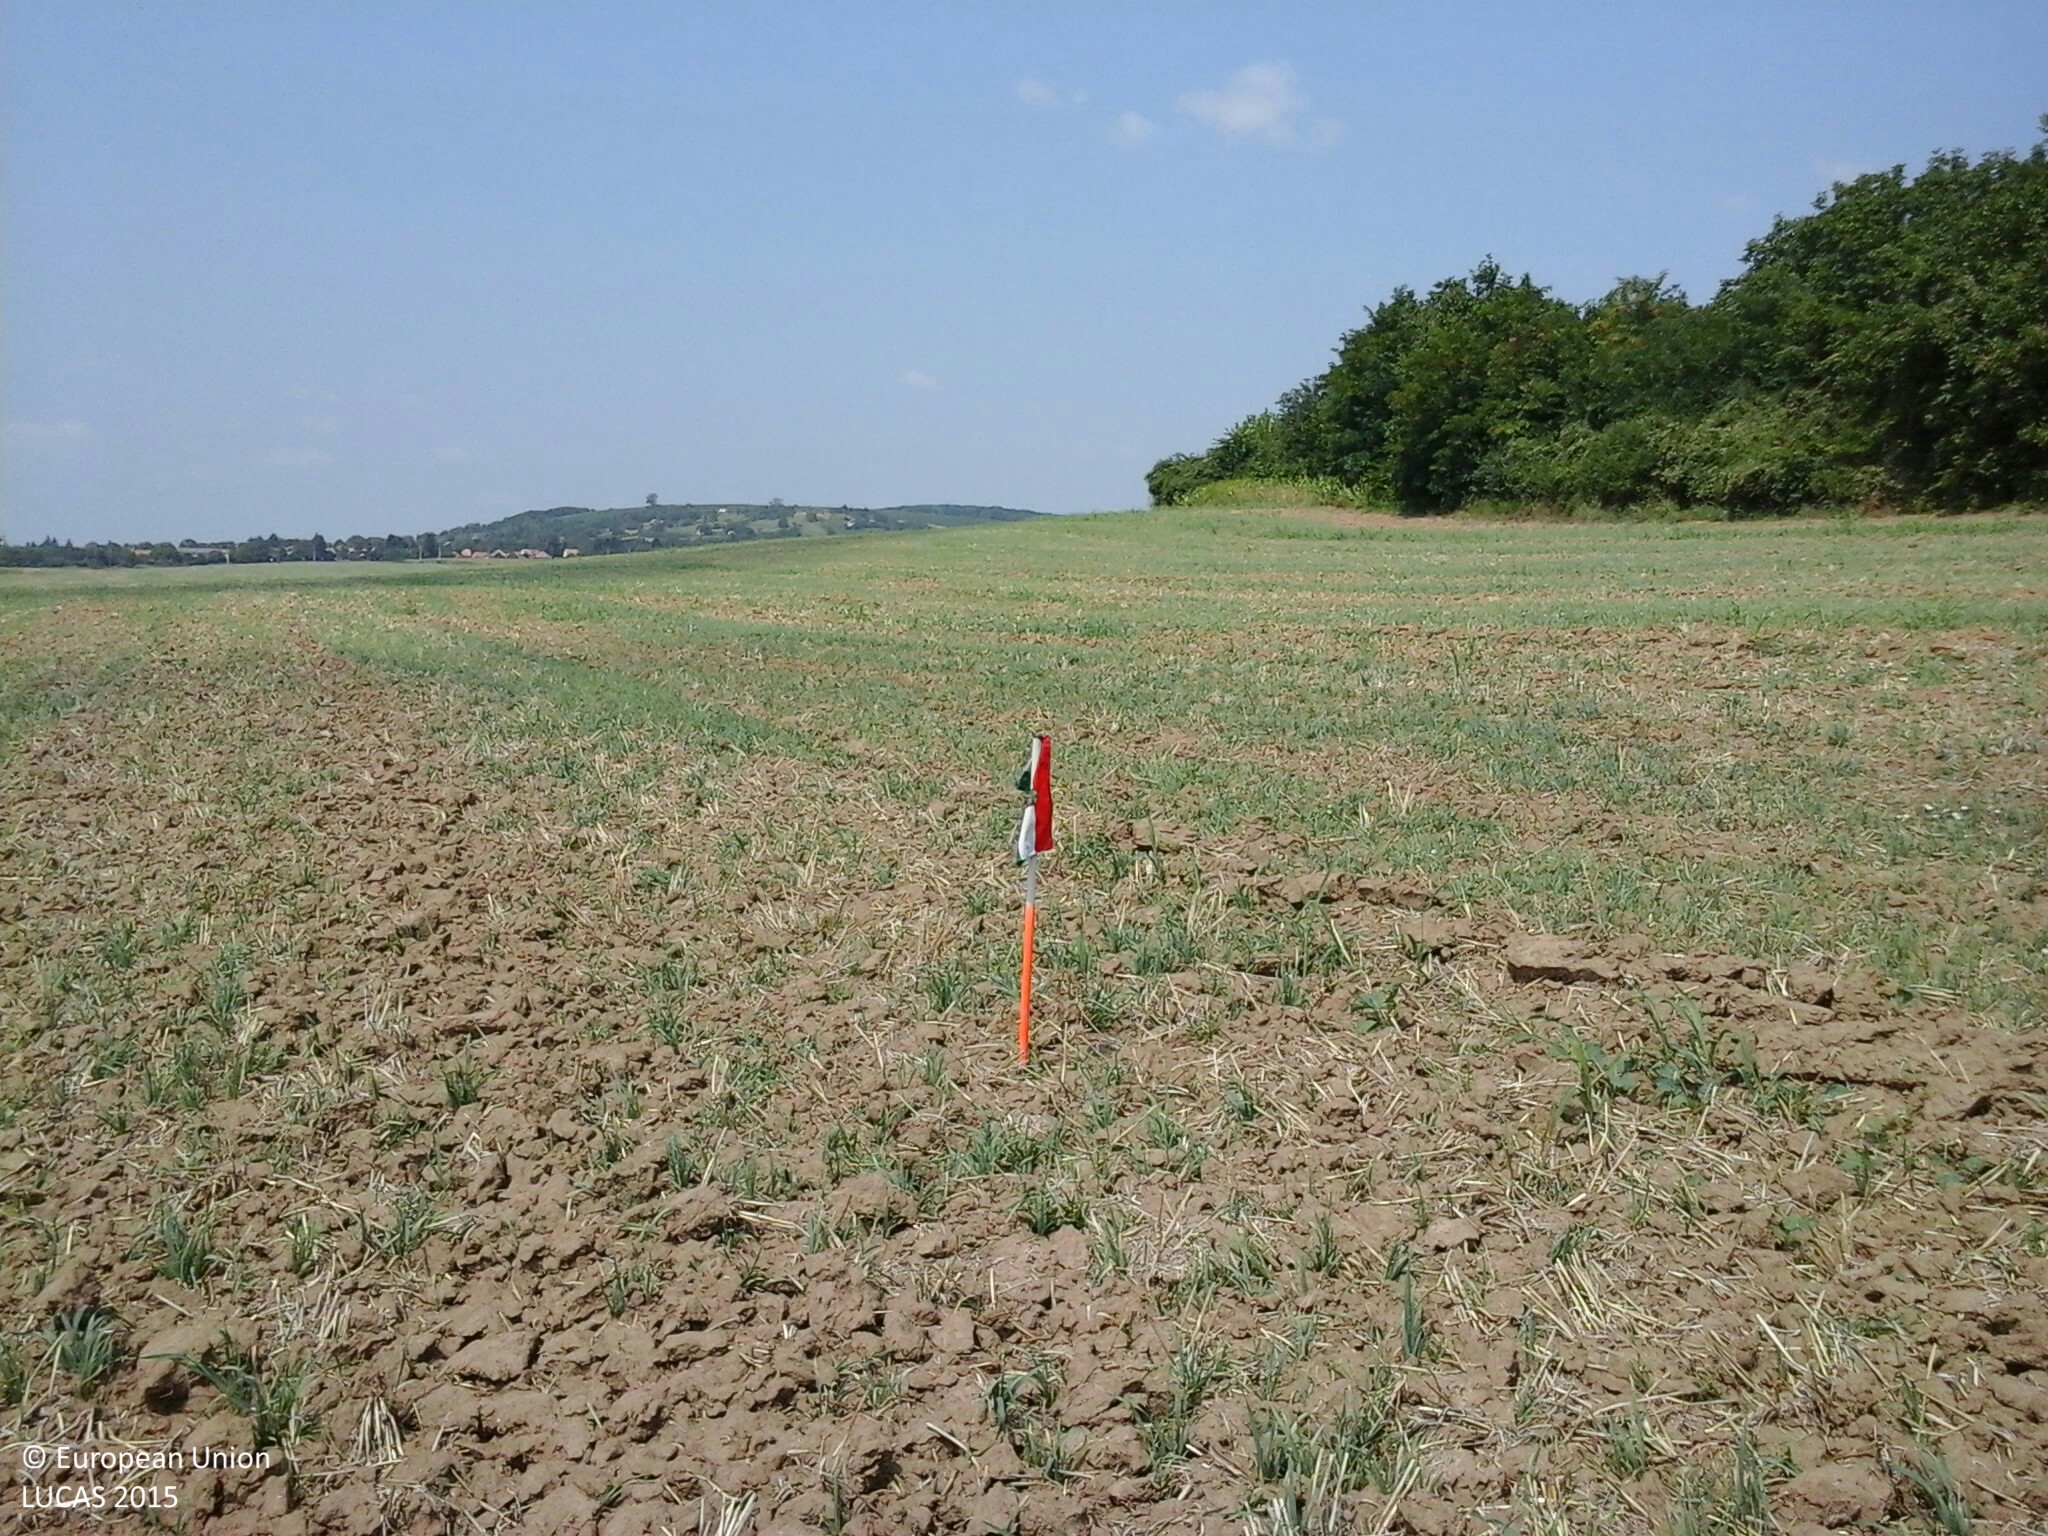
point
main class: Cropland
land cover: Common wheat
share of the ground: < 10 %
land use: Agriculture (excluding fallow land and kitchen gardens)
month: August
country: HU
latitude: 45.8741
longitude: 18.1870
